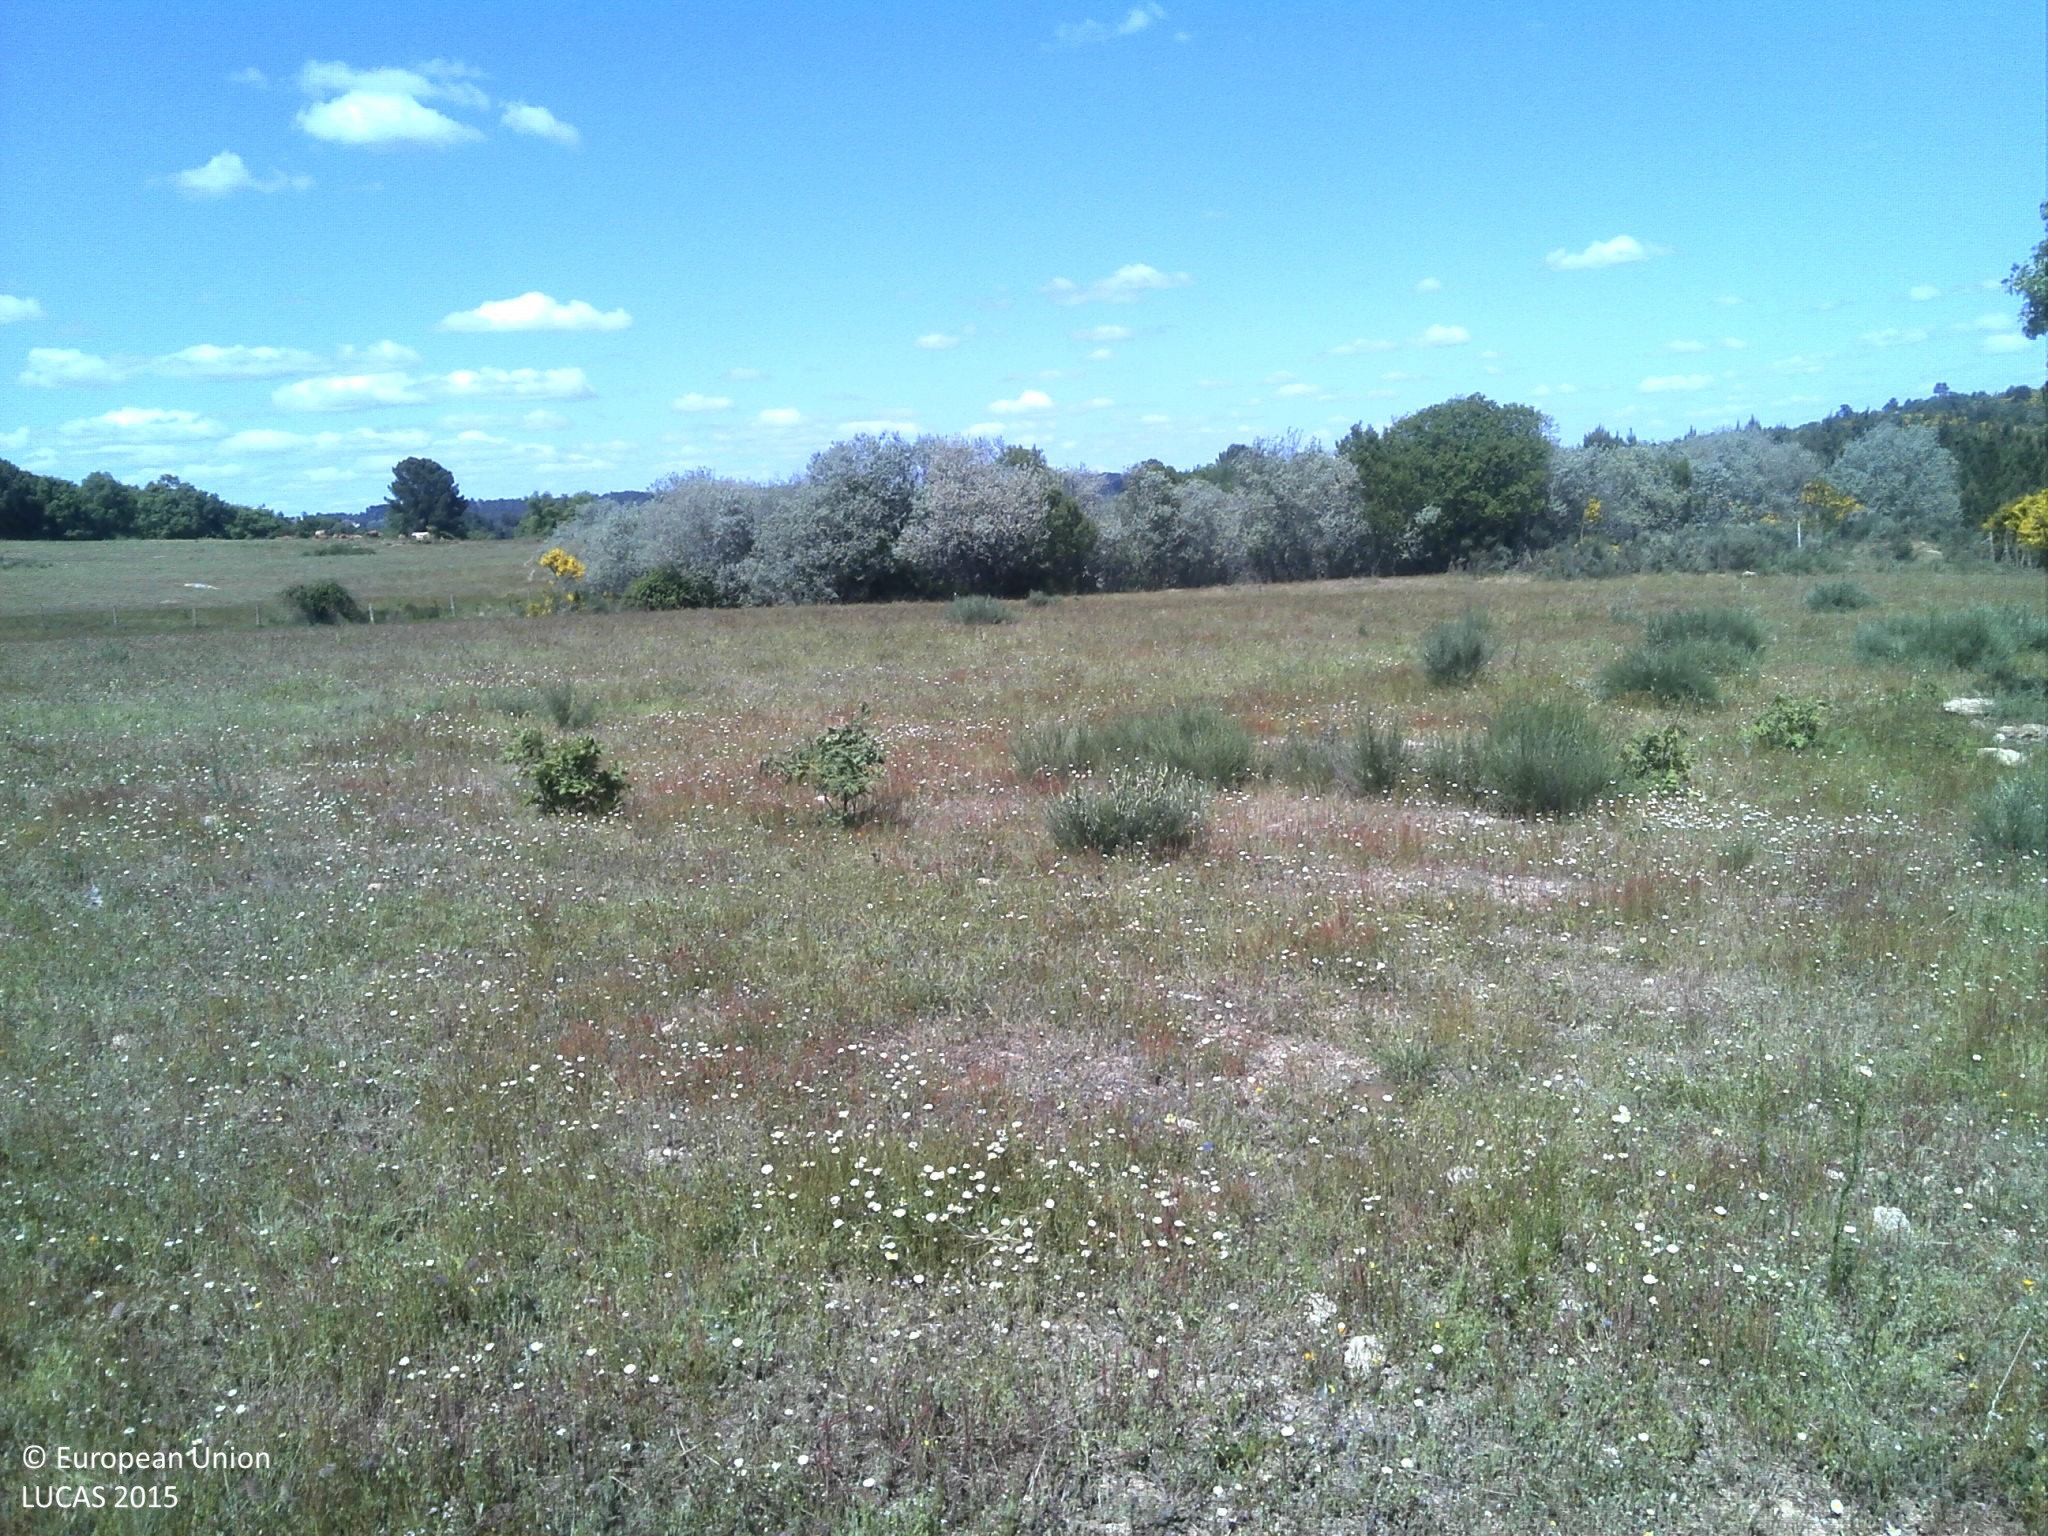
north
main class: Grassland
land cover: Grassland with sparse tree/shrub cover
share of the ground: 50 - 75 %
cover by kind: herbaceous plants 65 %, consolidated bare surface 20 %, broadleaved forest trees 5 %
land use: Agriculture (excluding fallow land and kitchen gardens)
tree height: < 5 m
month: May
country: PT
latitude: 40.4879
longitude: -7.1982
